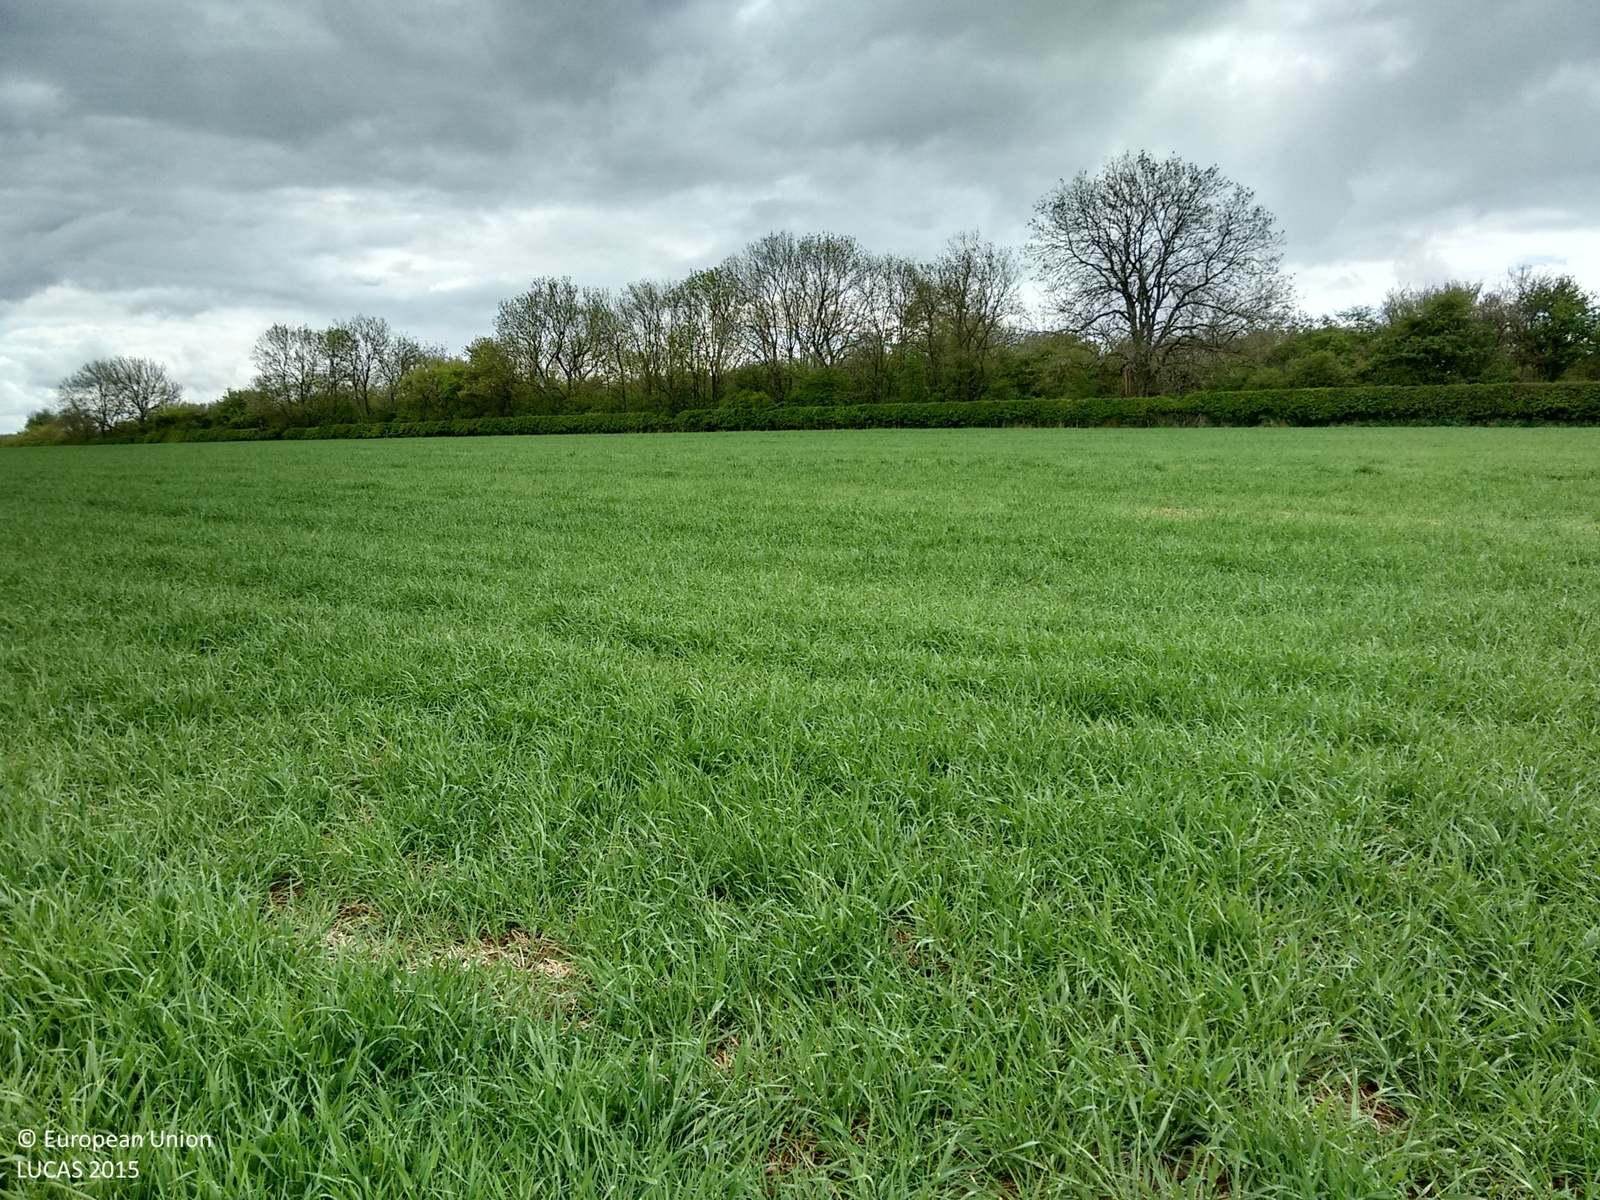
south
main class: Cropland
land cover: Barley
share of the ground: > 75 %
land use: Agriculture (excluding fallow land and kitchen gardens)
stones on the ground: 25 - 50 %
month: May
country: GB
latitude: 51.9694
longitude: -0.6513
